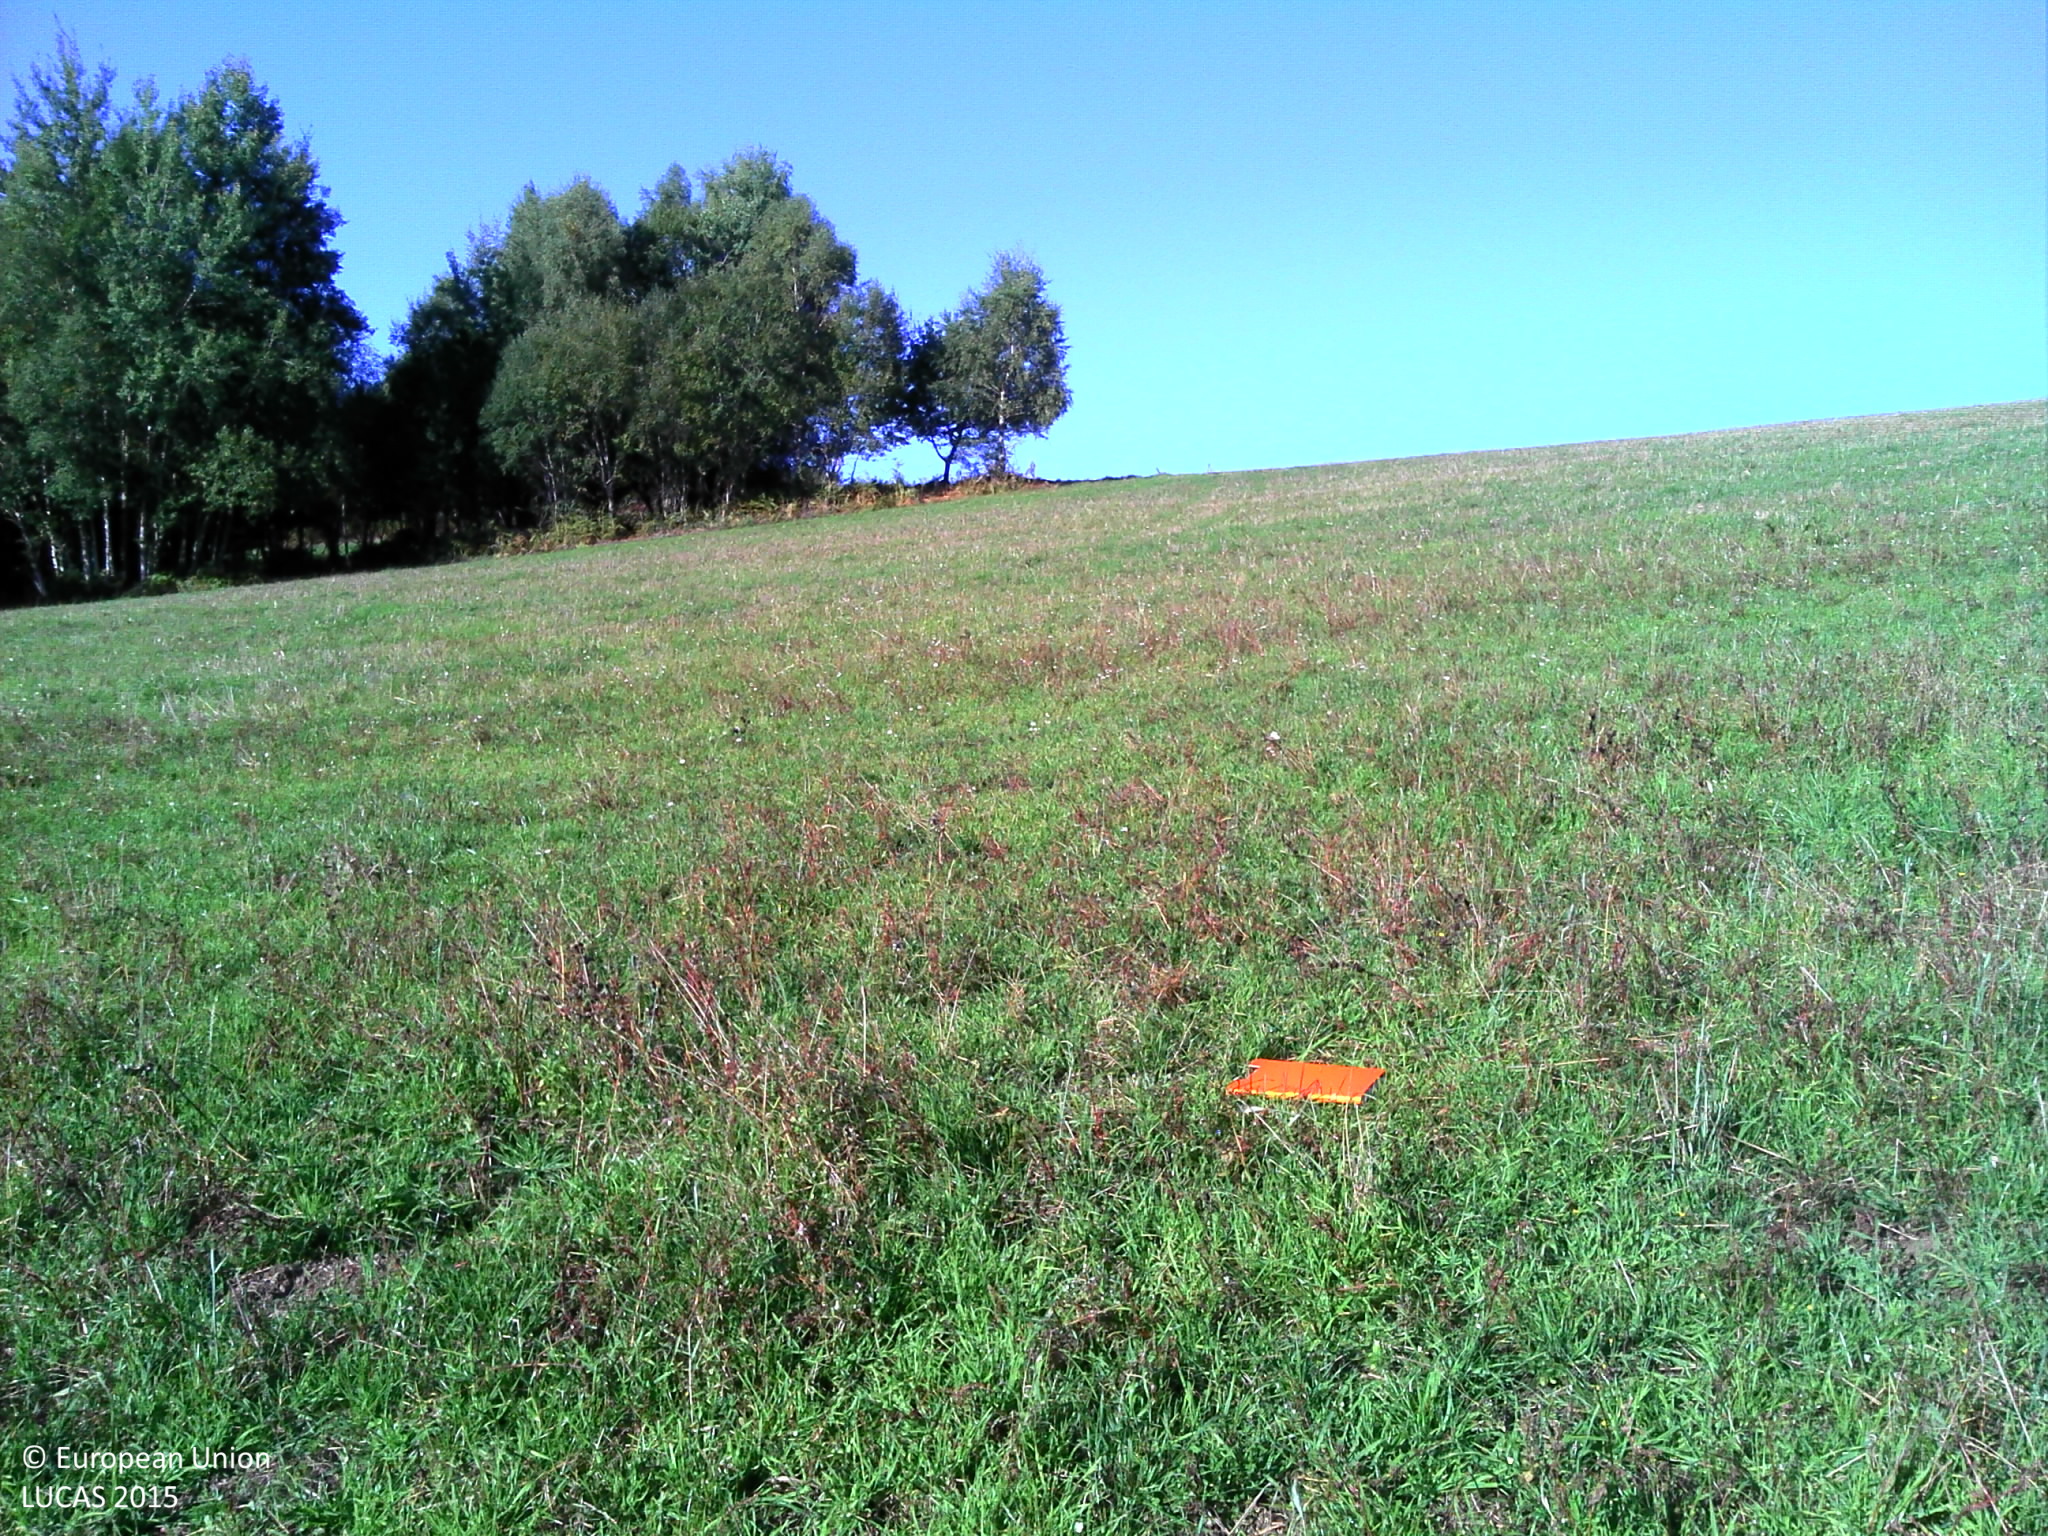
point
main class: Grassland
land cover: Grassland without tree/shrub cover
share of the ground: > 75 %
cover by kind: herbaceous plants 100 %
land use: Agriculture (excluding fallow land and kitchen gardens)
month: September
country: FR
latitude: 45.8014
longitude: 2.8063
